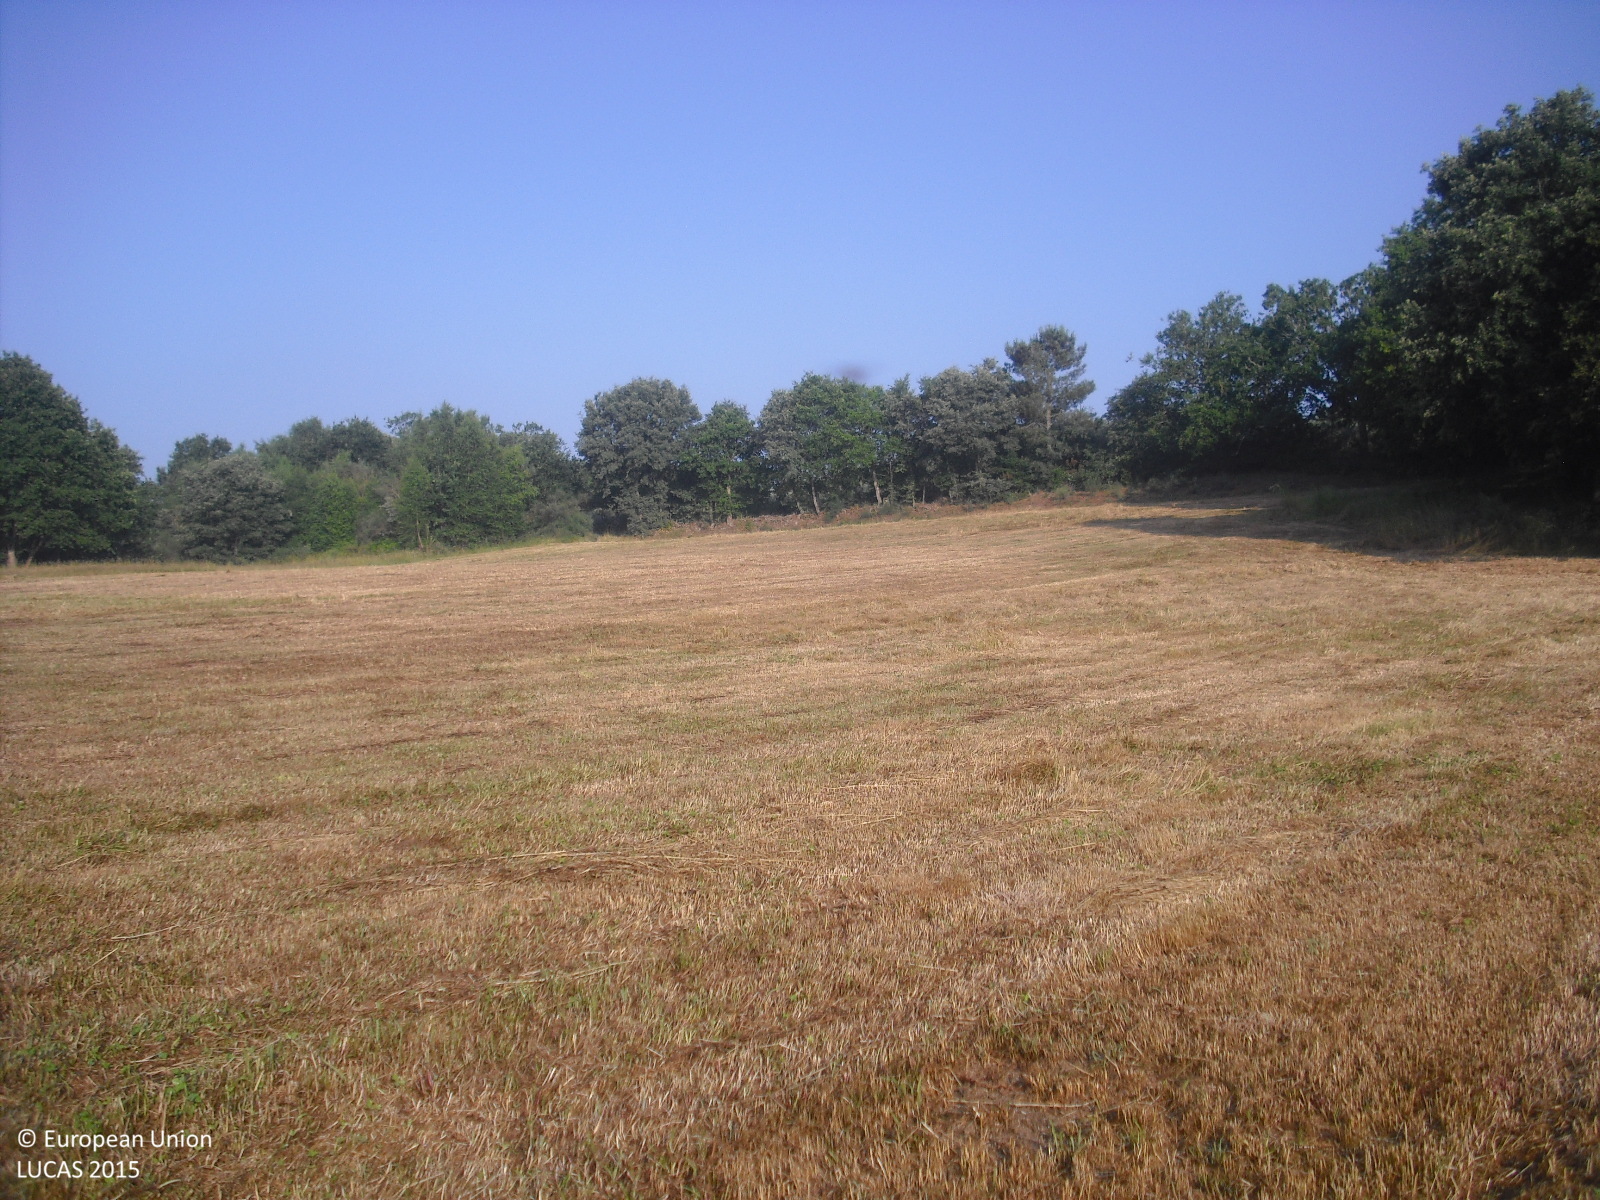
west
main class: Cropland
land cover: Temporary grasslands
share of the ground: > 75 %
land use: Agriculture (excluding fallow land and kitchen gardens)
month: June
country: ES
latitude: 42.5391
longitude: -7.7941
